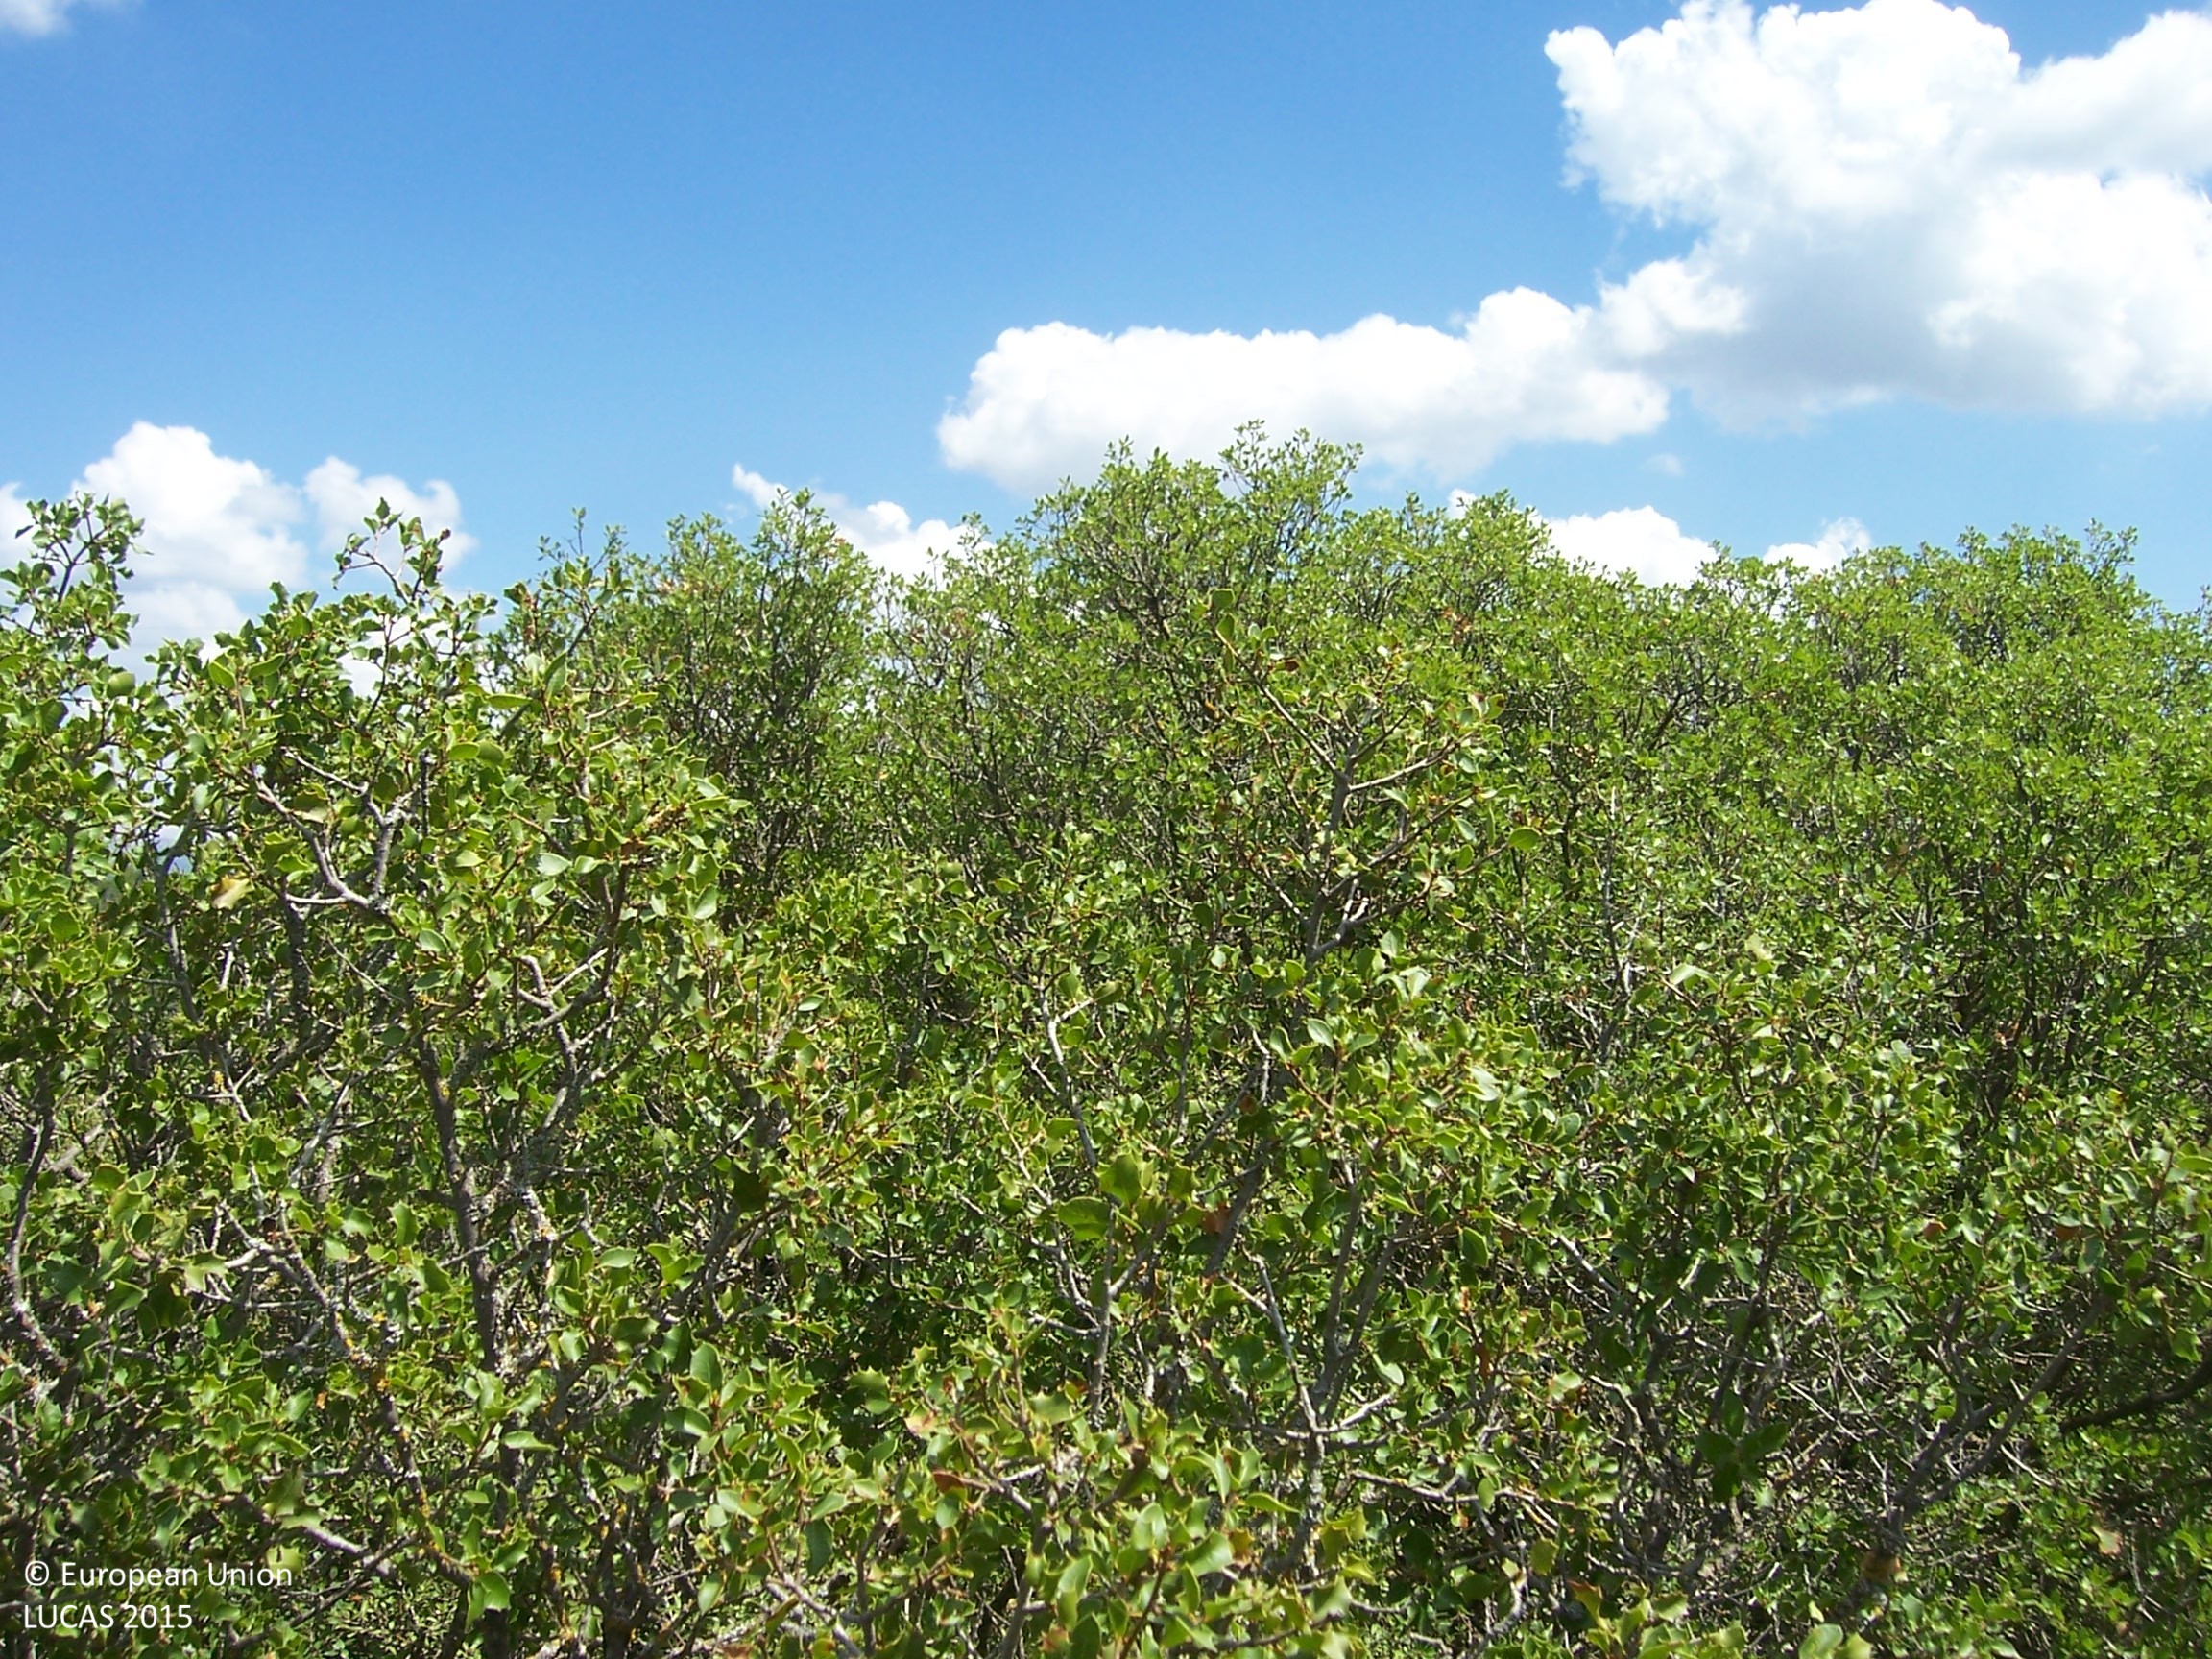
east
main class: Shrubland
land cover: Shrubland without tree cover
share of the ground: > 75 %
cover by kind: shrubs 85 %, unconsolidated bare surface 15 %
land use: Semi-natural and natural areas not in use
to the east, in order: Shrubland without tree cover; Grassland without tree/shrub cover; Electric lines; Grassland without tree/shrub cover; Shrubland without tree cover; Tracks; Broadleaved woodland; Lucerne; Grass margins; Paved roads, cycling and walking lanes; Shruby margins; Lucerne
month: August
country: ES
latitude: 41.9737
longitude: 0.5354
